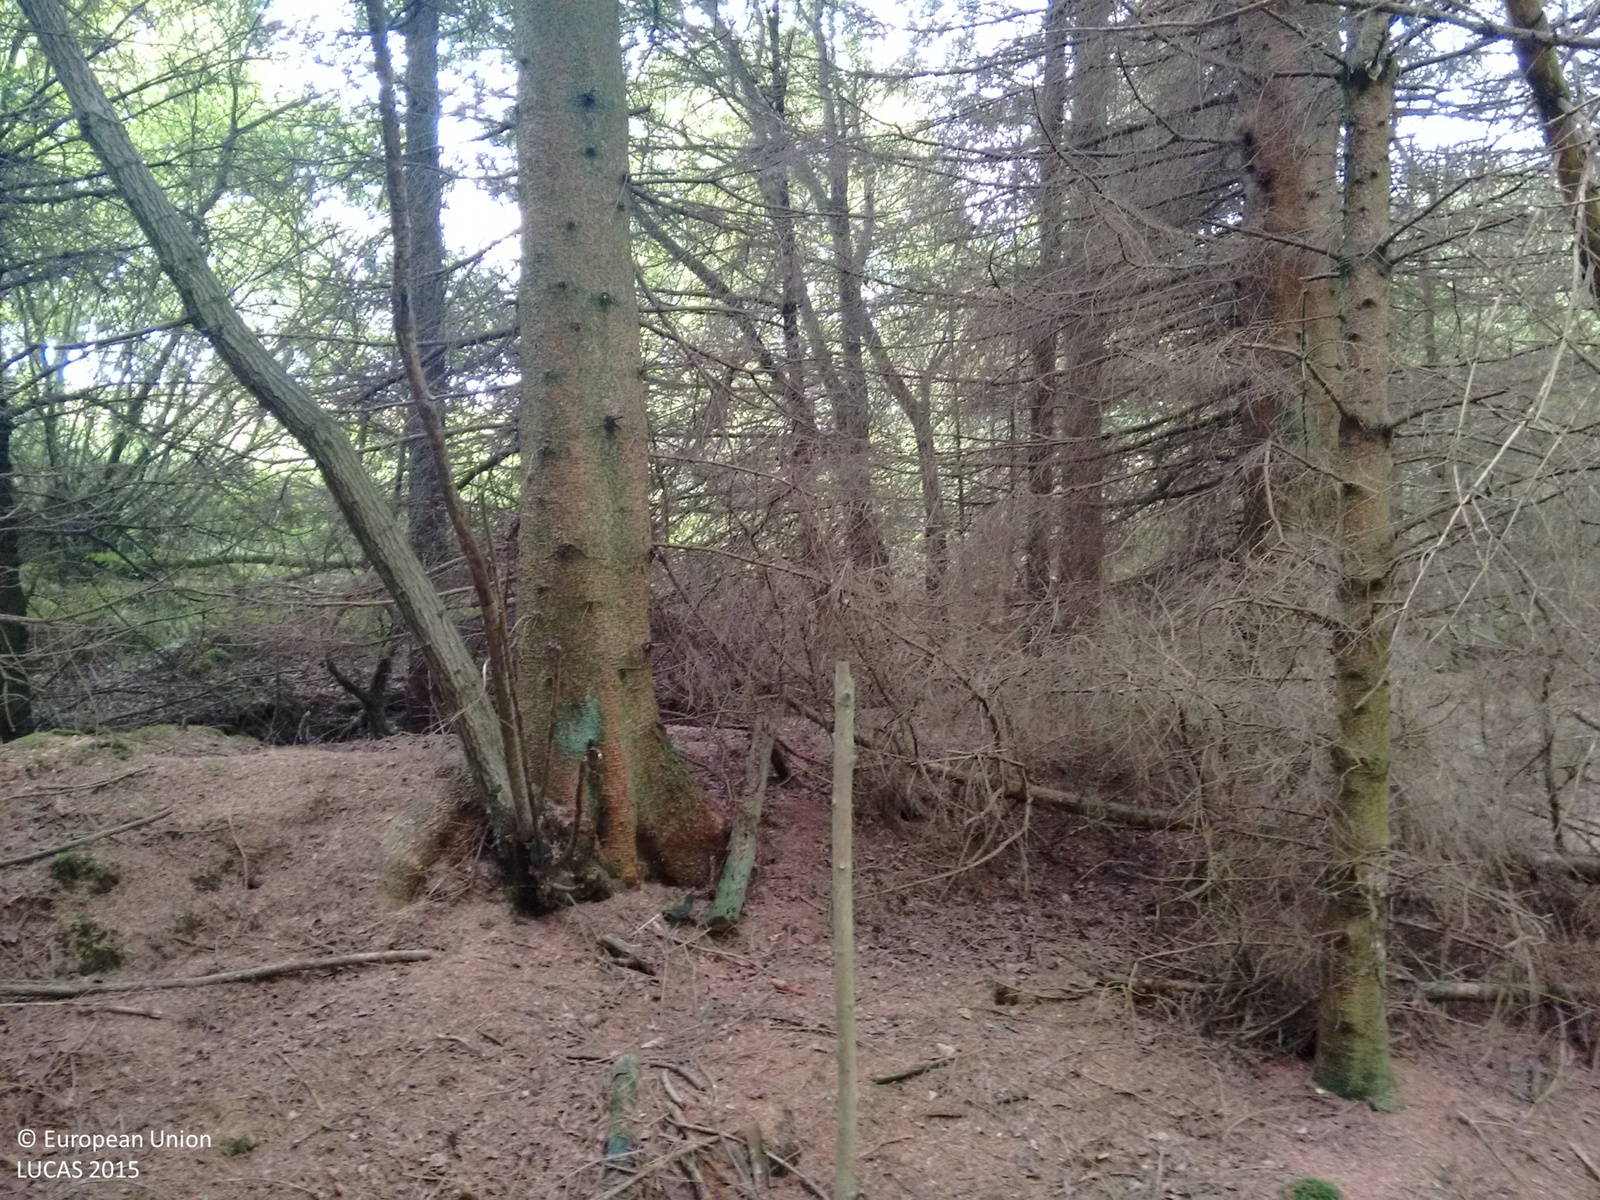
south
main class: Woodland
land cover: Spruce dominated mixed woodland
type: exotic forest
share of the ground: > 75 %
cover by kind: coniferous forest trees 75 %, broadleaved forest trees 25 %
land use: Forestry
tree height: > 5 m
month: August
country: GB
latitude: 53.0435
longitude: -3.4930
